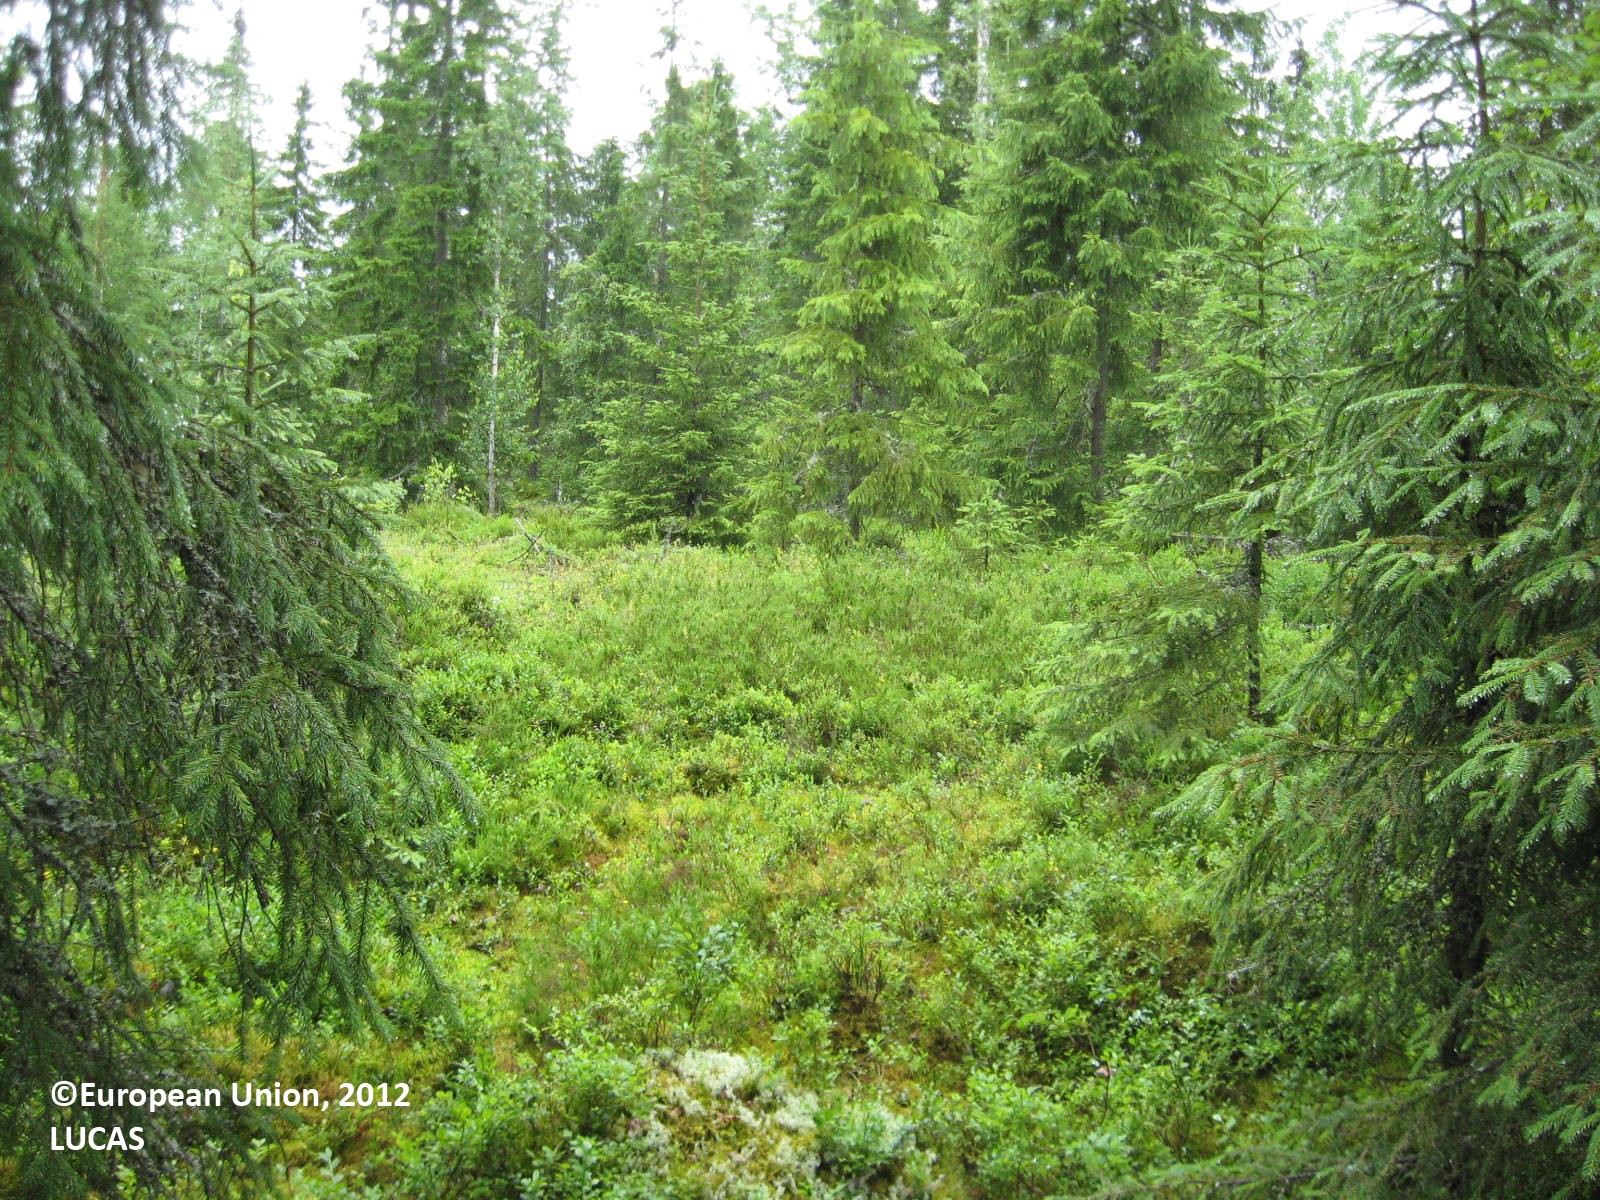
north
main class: Woodland
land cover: Pine dominated coniferous woodland
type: boreal forest
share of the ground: > 75 %
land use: Forestry
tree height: > 5 m
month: July
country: FI
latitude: 62.3425
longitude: 22.7477
